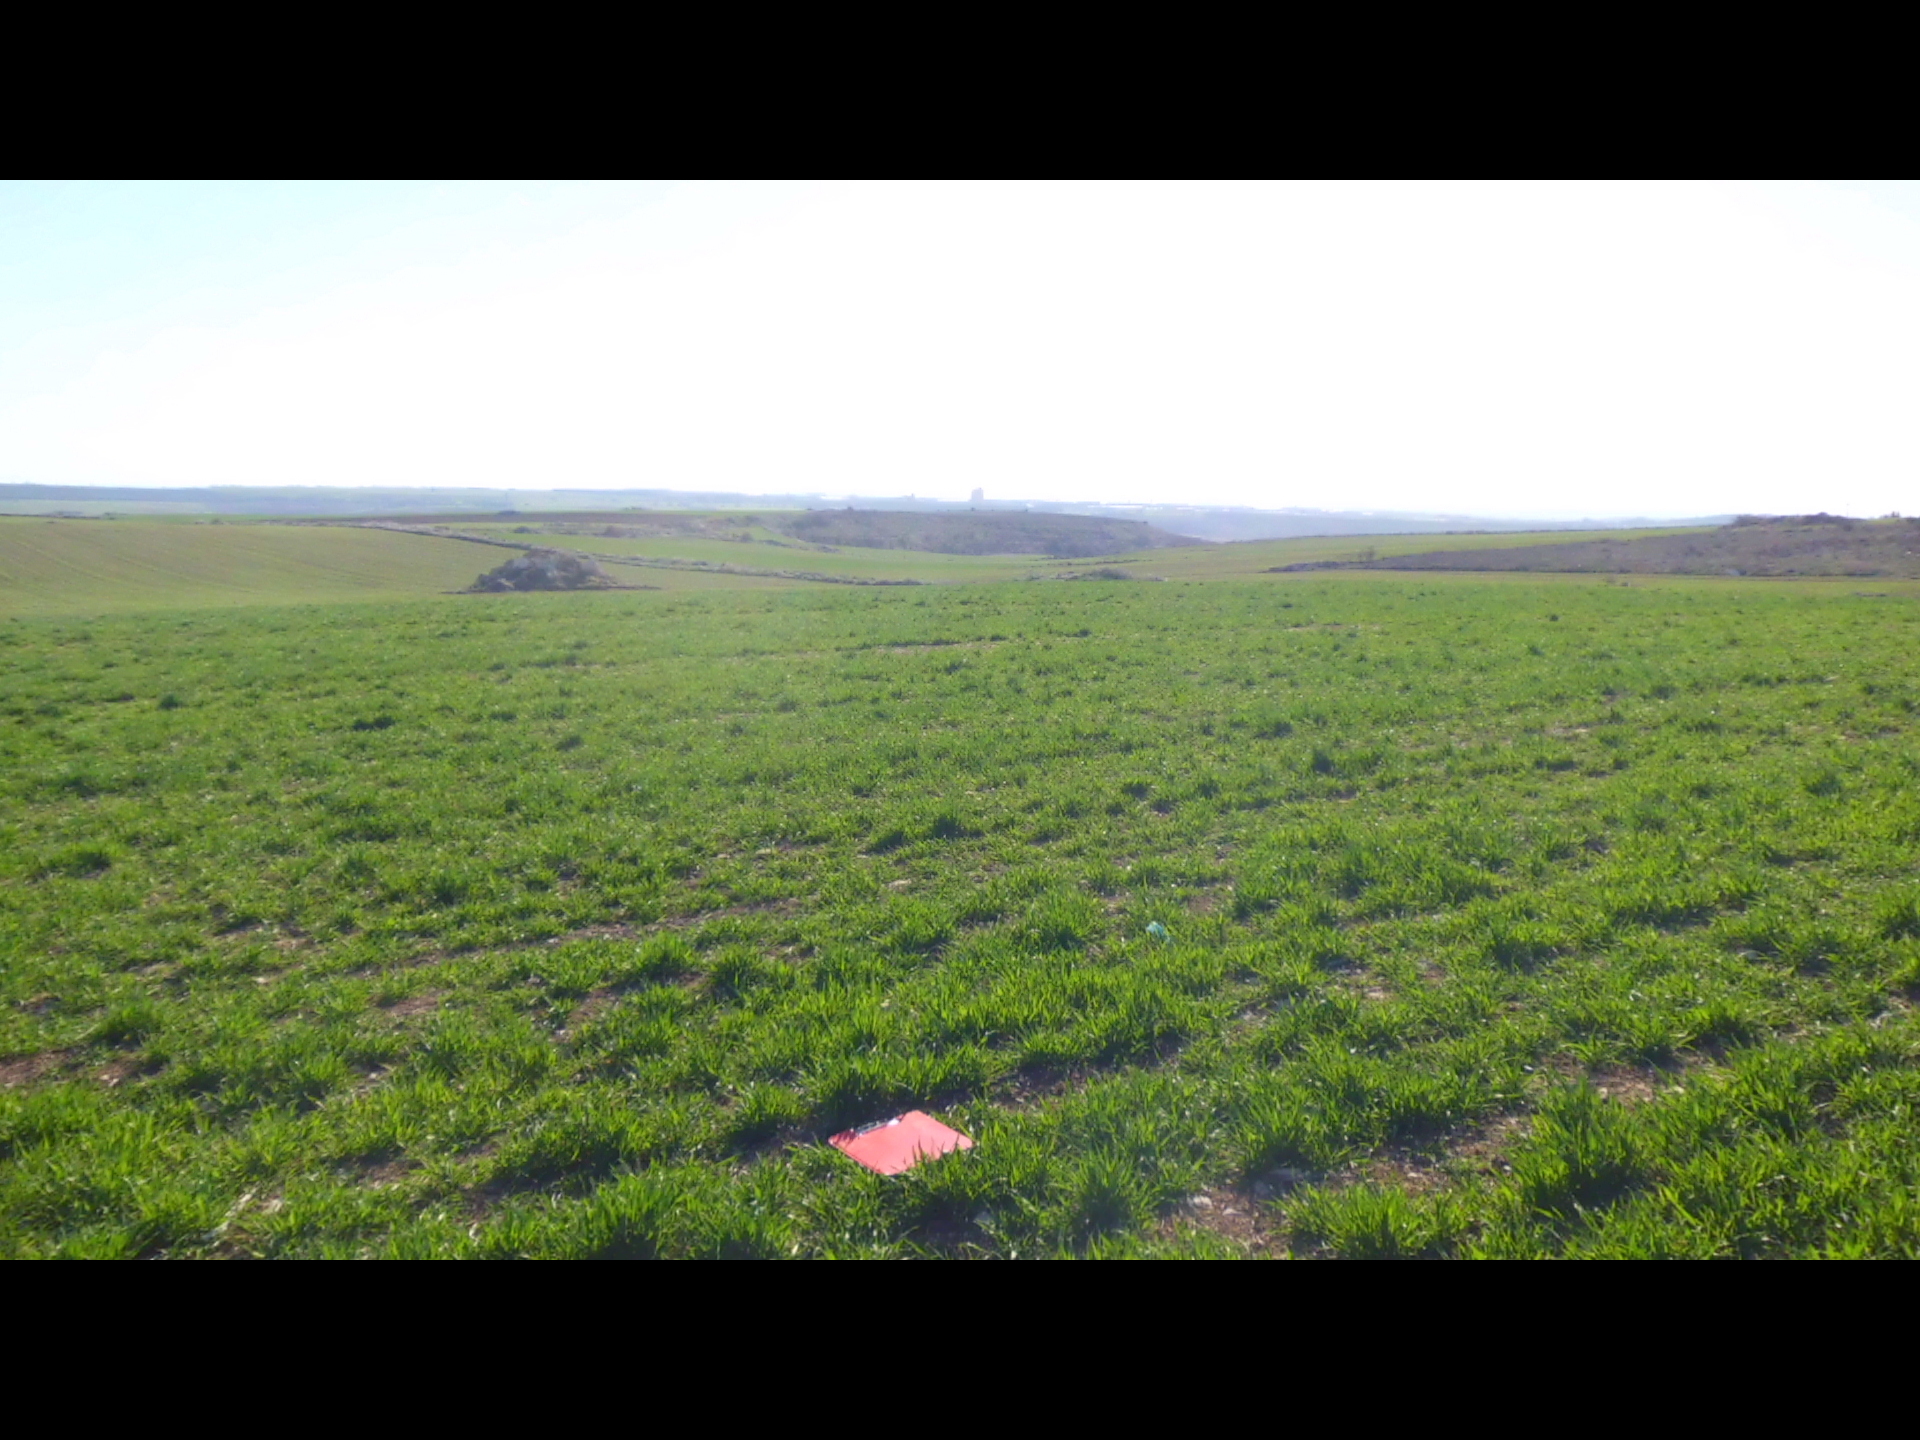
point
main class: Cropland
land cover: Barley
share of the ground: > 75 %
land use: Agriculture (excluding fallow land and kitchen gardens)
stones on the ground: < 10 %
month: April
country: ES
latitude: 42.3091
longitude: -3.6592
